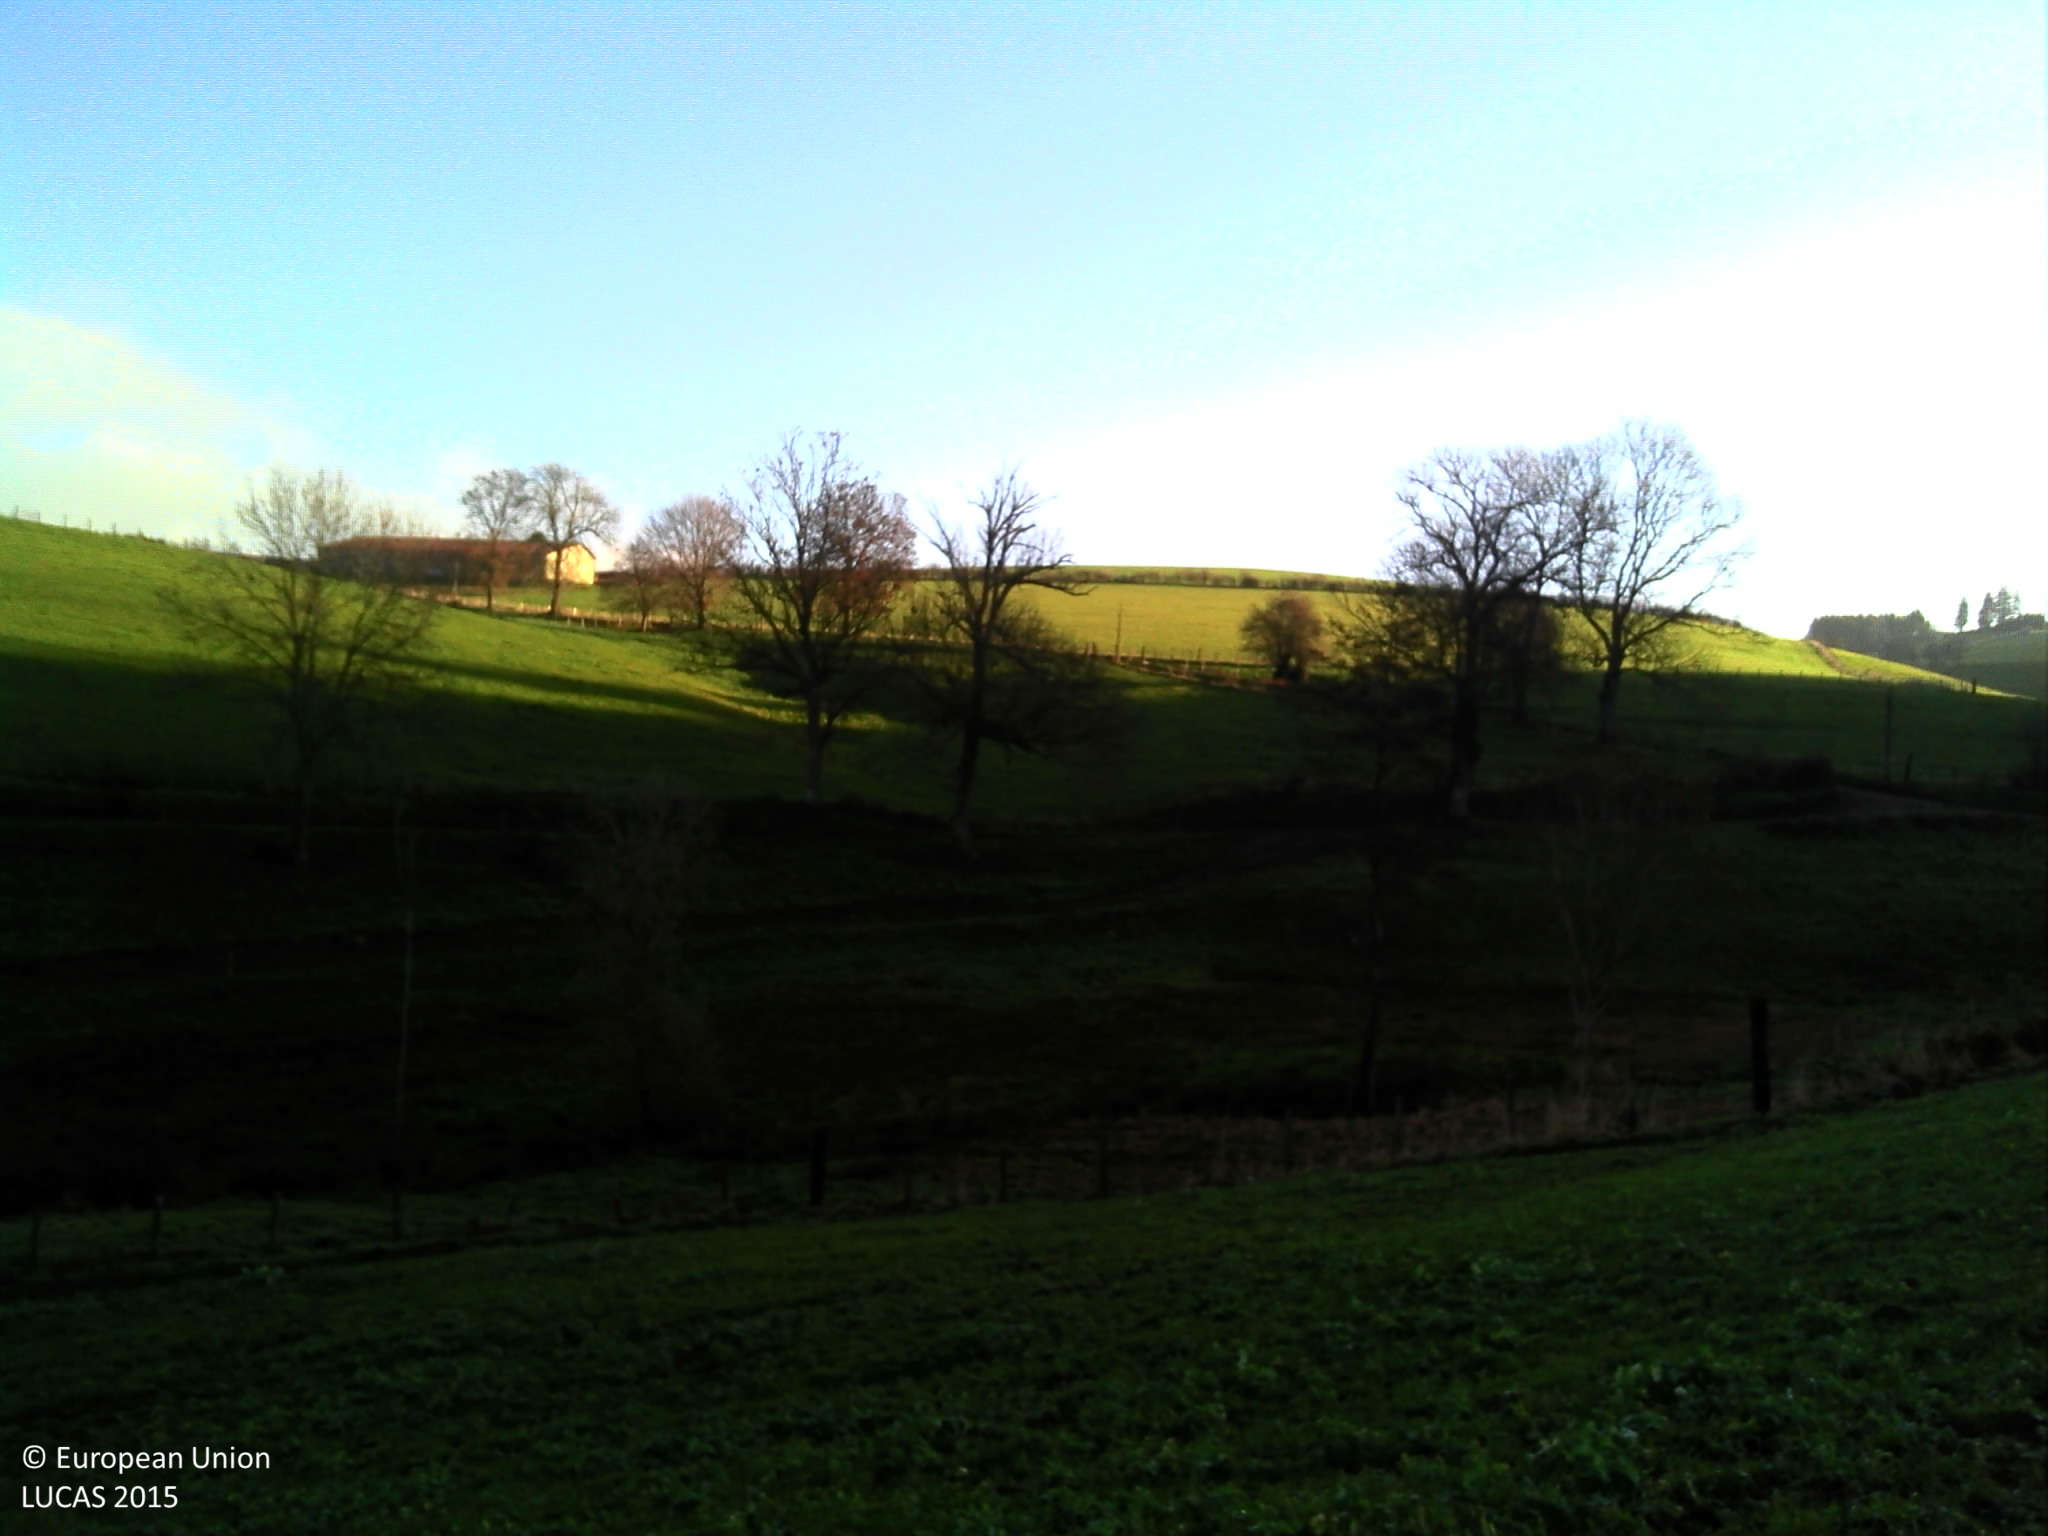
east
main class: Cropland
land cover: Rape and turnip rape
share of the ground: > 75 %
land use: Agriculture (excluding fallow land and kitchen gardens)
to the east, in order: Rape and turnip rape; Electric lines; Rape and turnip rape; Spontaneously vegetated surfaces; Fences; Grassland without tree/shrub cover; Ditches and canals; Grassland without tree/shrub cover; Fences; Tracks; Grassland with sparse tree/shrub cover; Fences; Grass margins; Tracks; Grass margins; Fences; Grassland with sparse tree/shrub cover; Fences; Grassland without tree/shrub cover
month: December
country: FR
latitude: 45.5588
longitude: 4.4821
